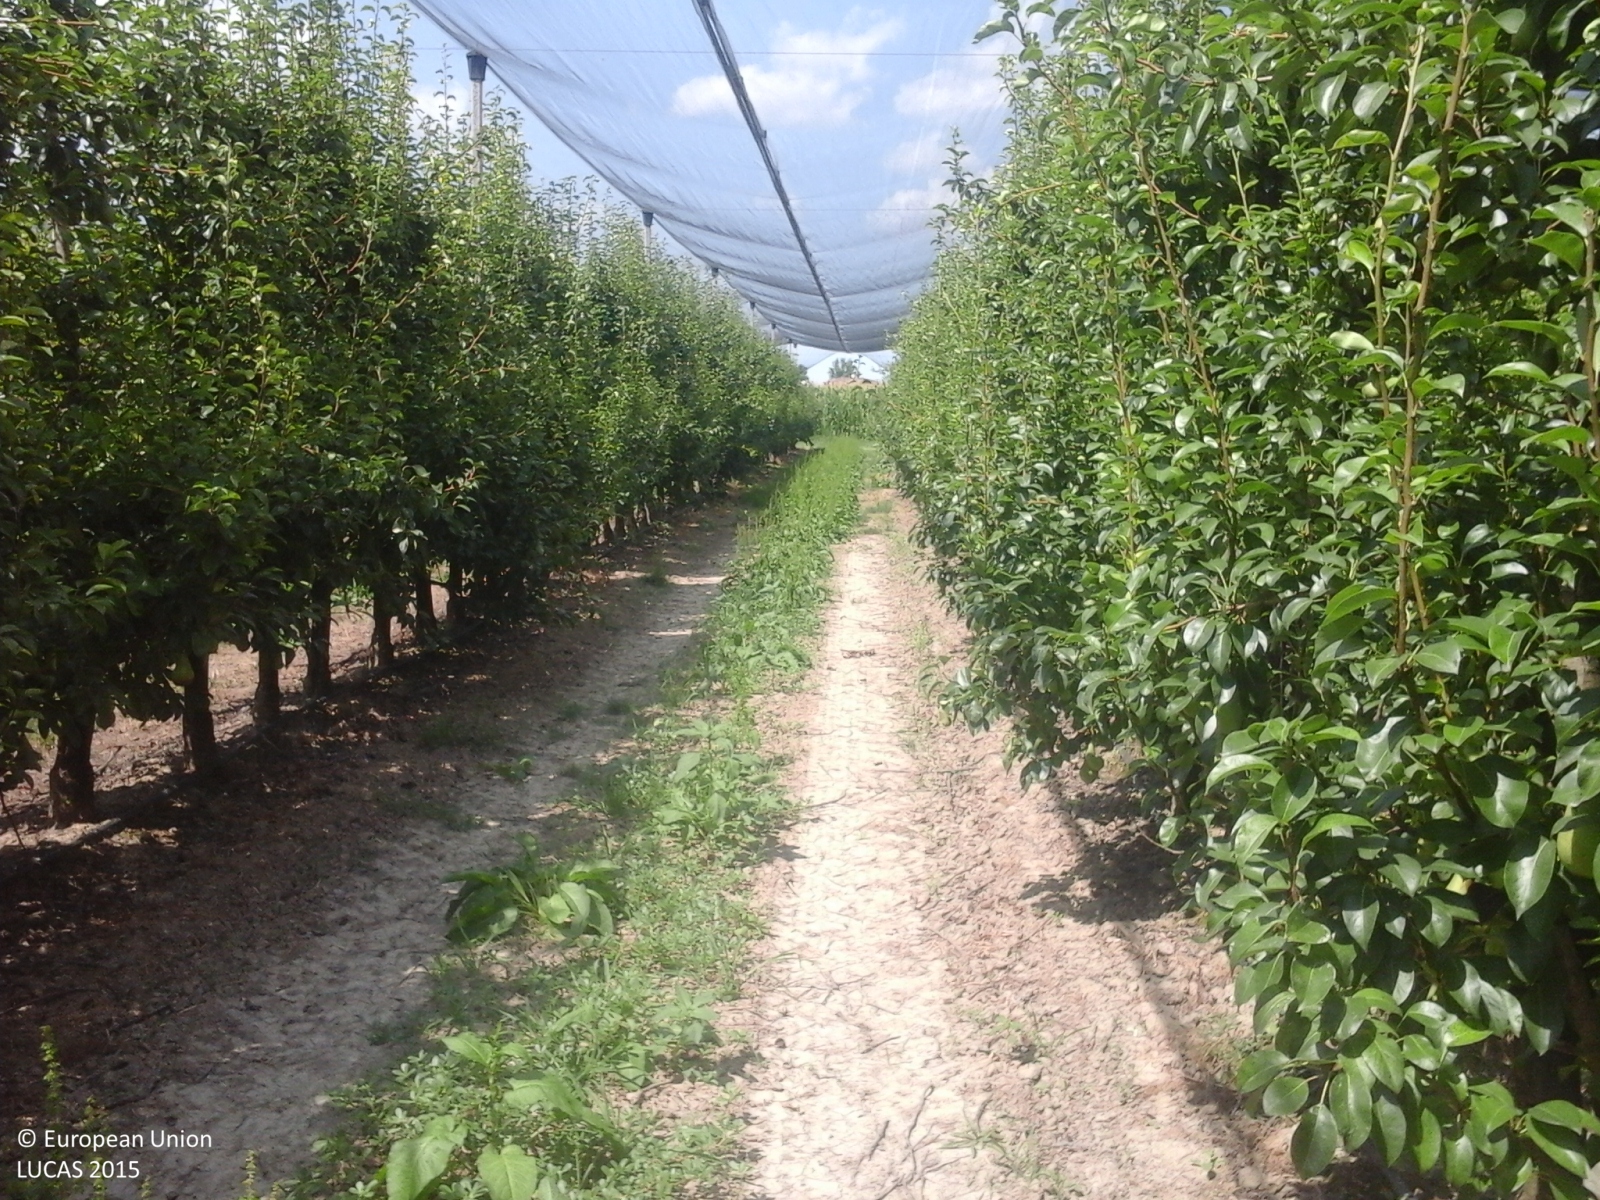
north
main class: Cropland
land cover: Pear fruit
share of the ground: > 75 %
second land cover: Grassland without tree/shrub cover
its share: > 75 %
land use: Agriculture (excluding fallow land and kitchen gardens)
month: June
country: IT
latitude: 44.8858
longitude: 11.0993
